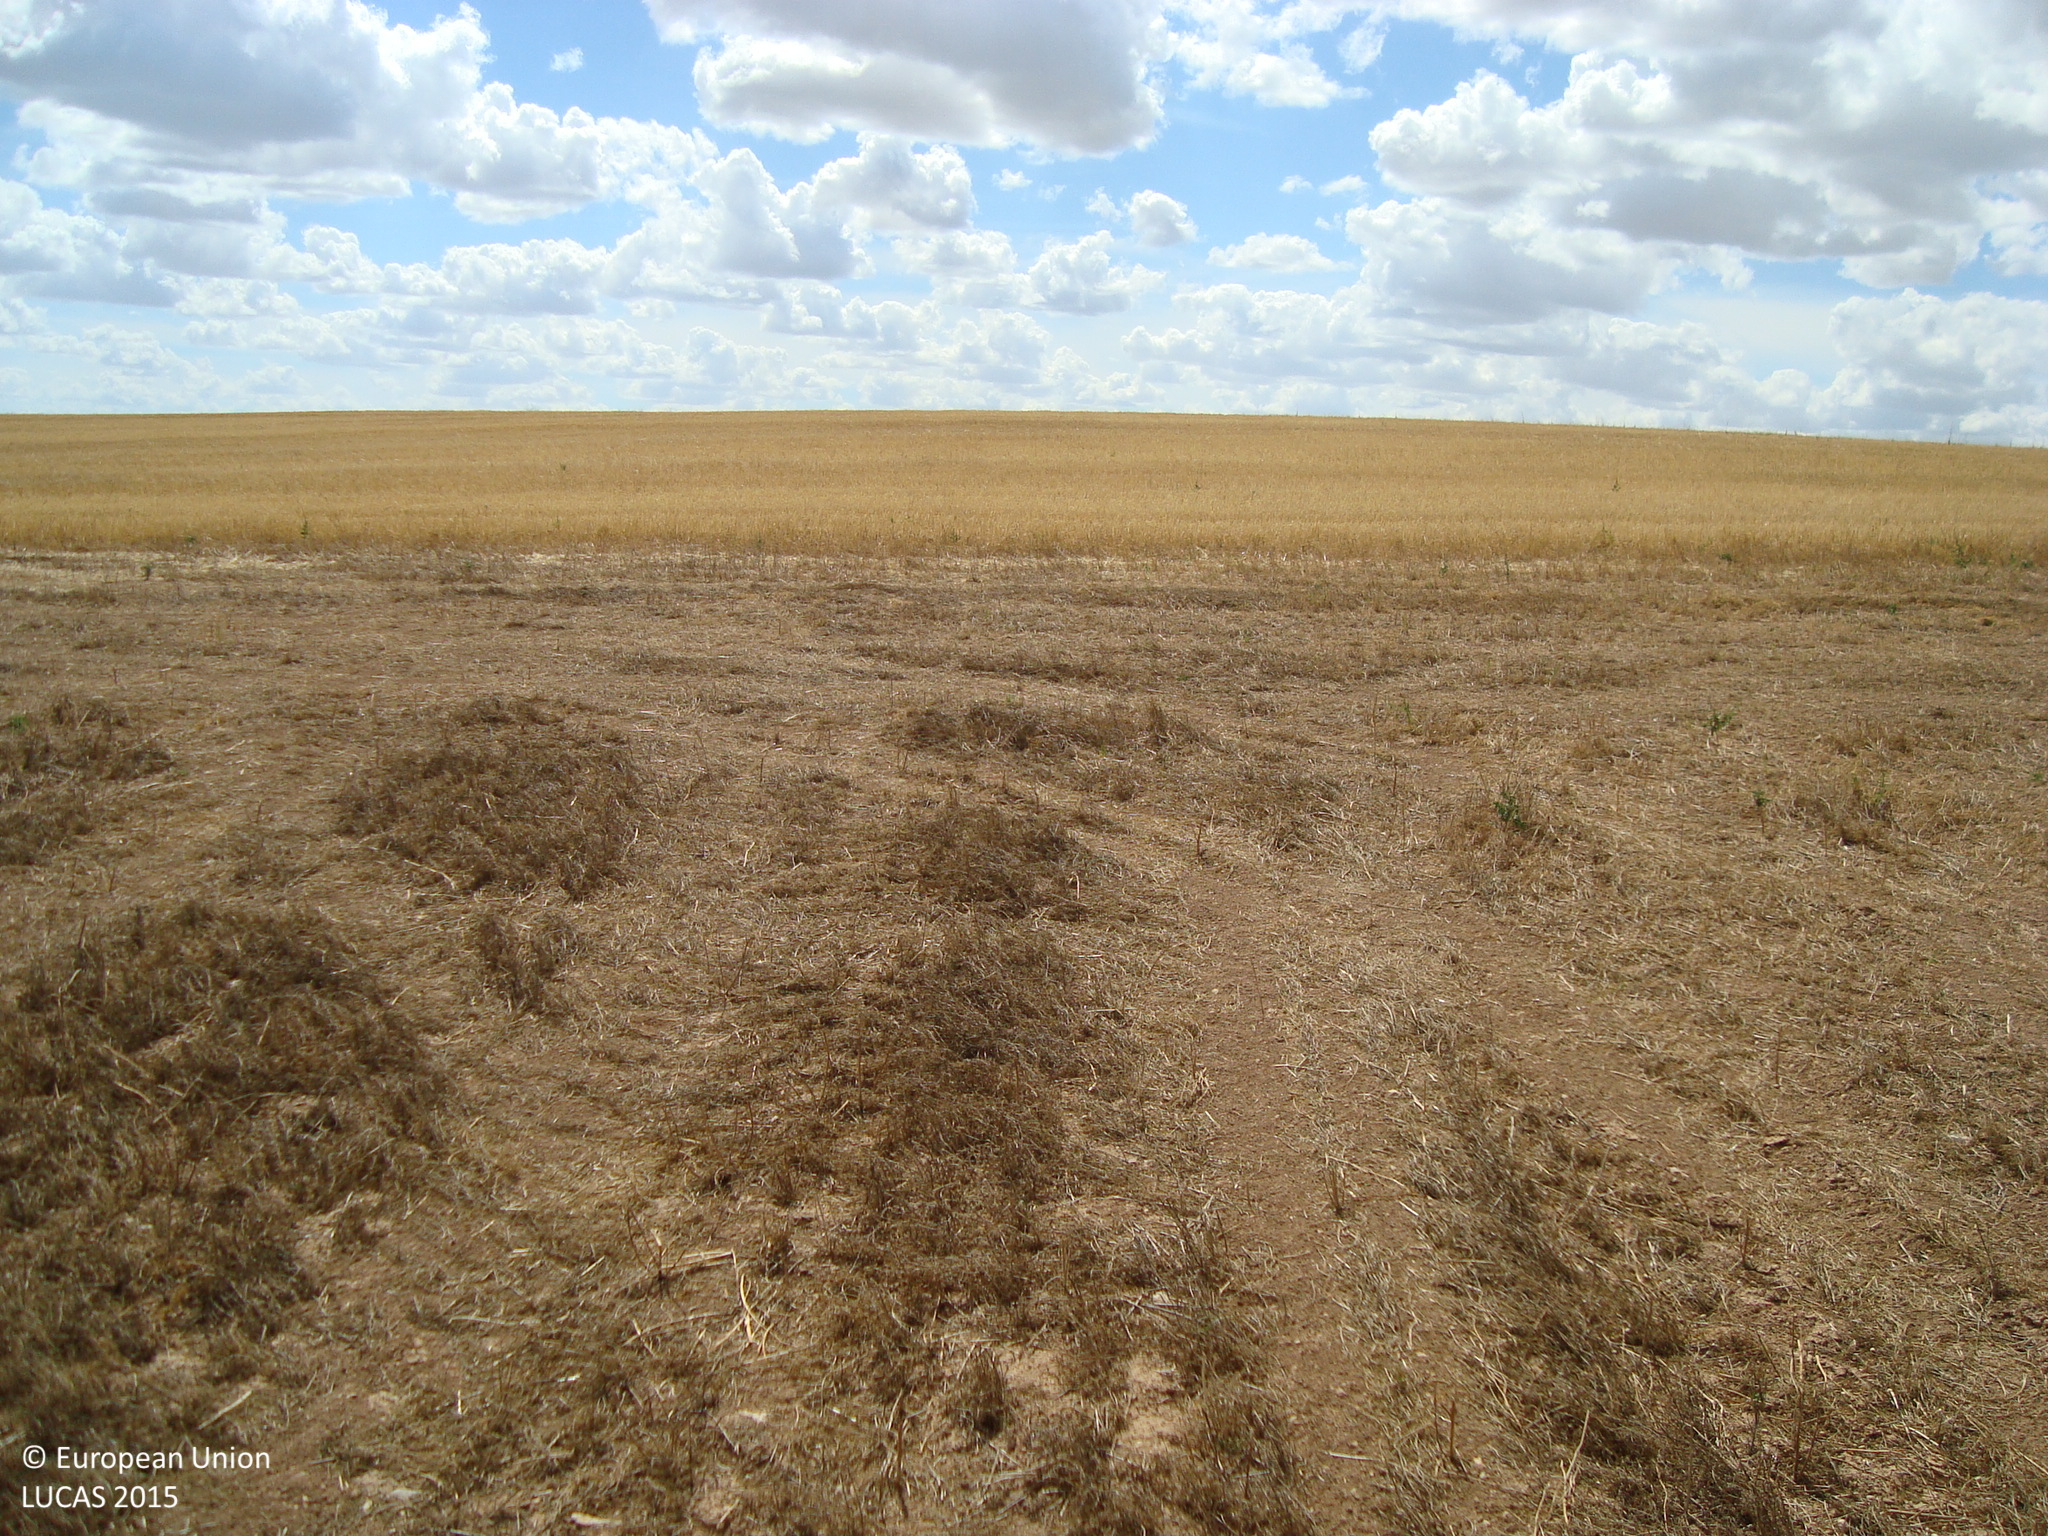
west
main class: Cropland
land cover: Dry pulses
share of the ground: > 75 %
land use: Agriculture (excluding fallow land and kitchen gardens)
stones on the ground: < 10 %
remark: Harvested field
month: July
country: ES
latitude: 41.9328
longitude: -3.8673
